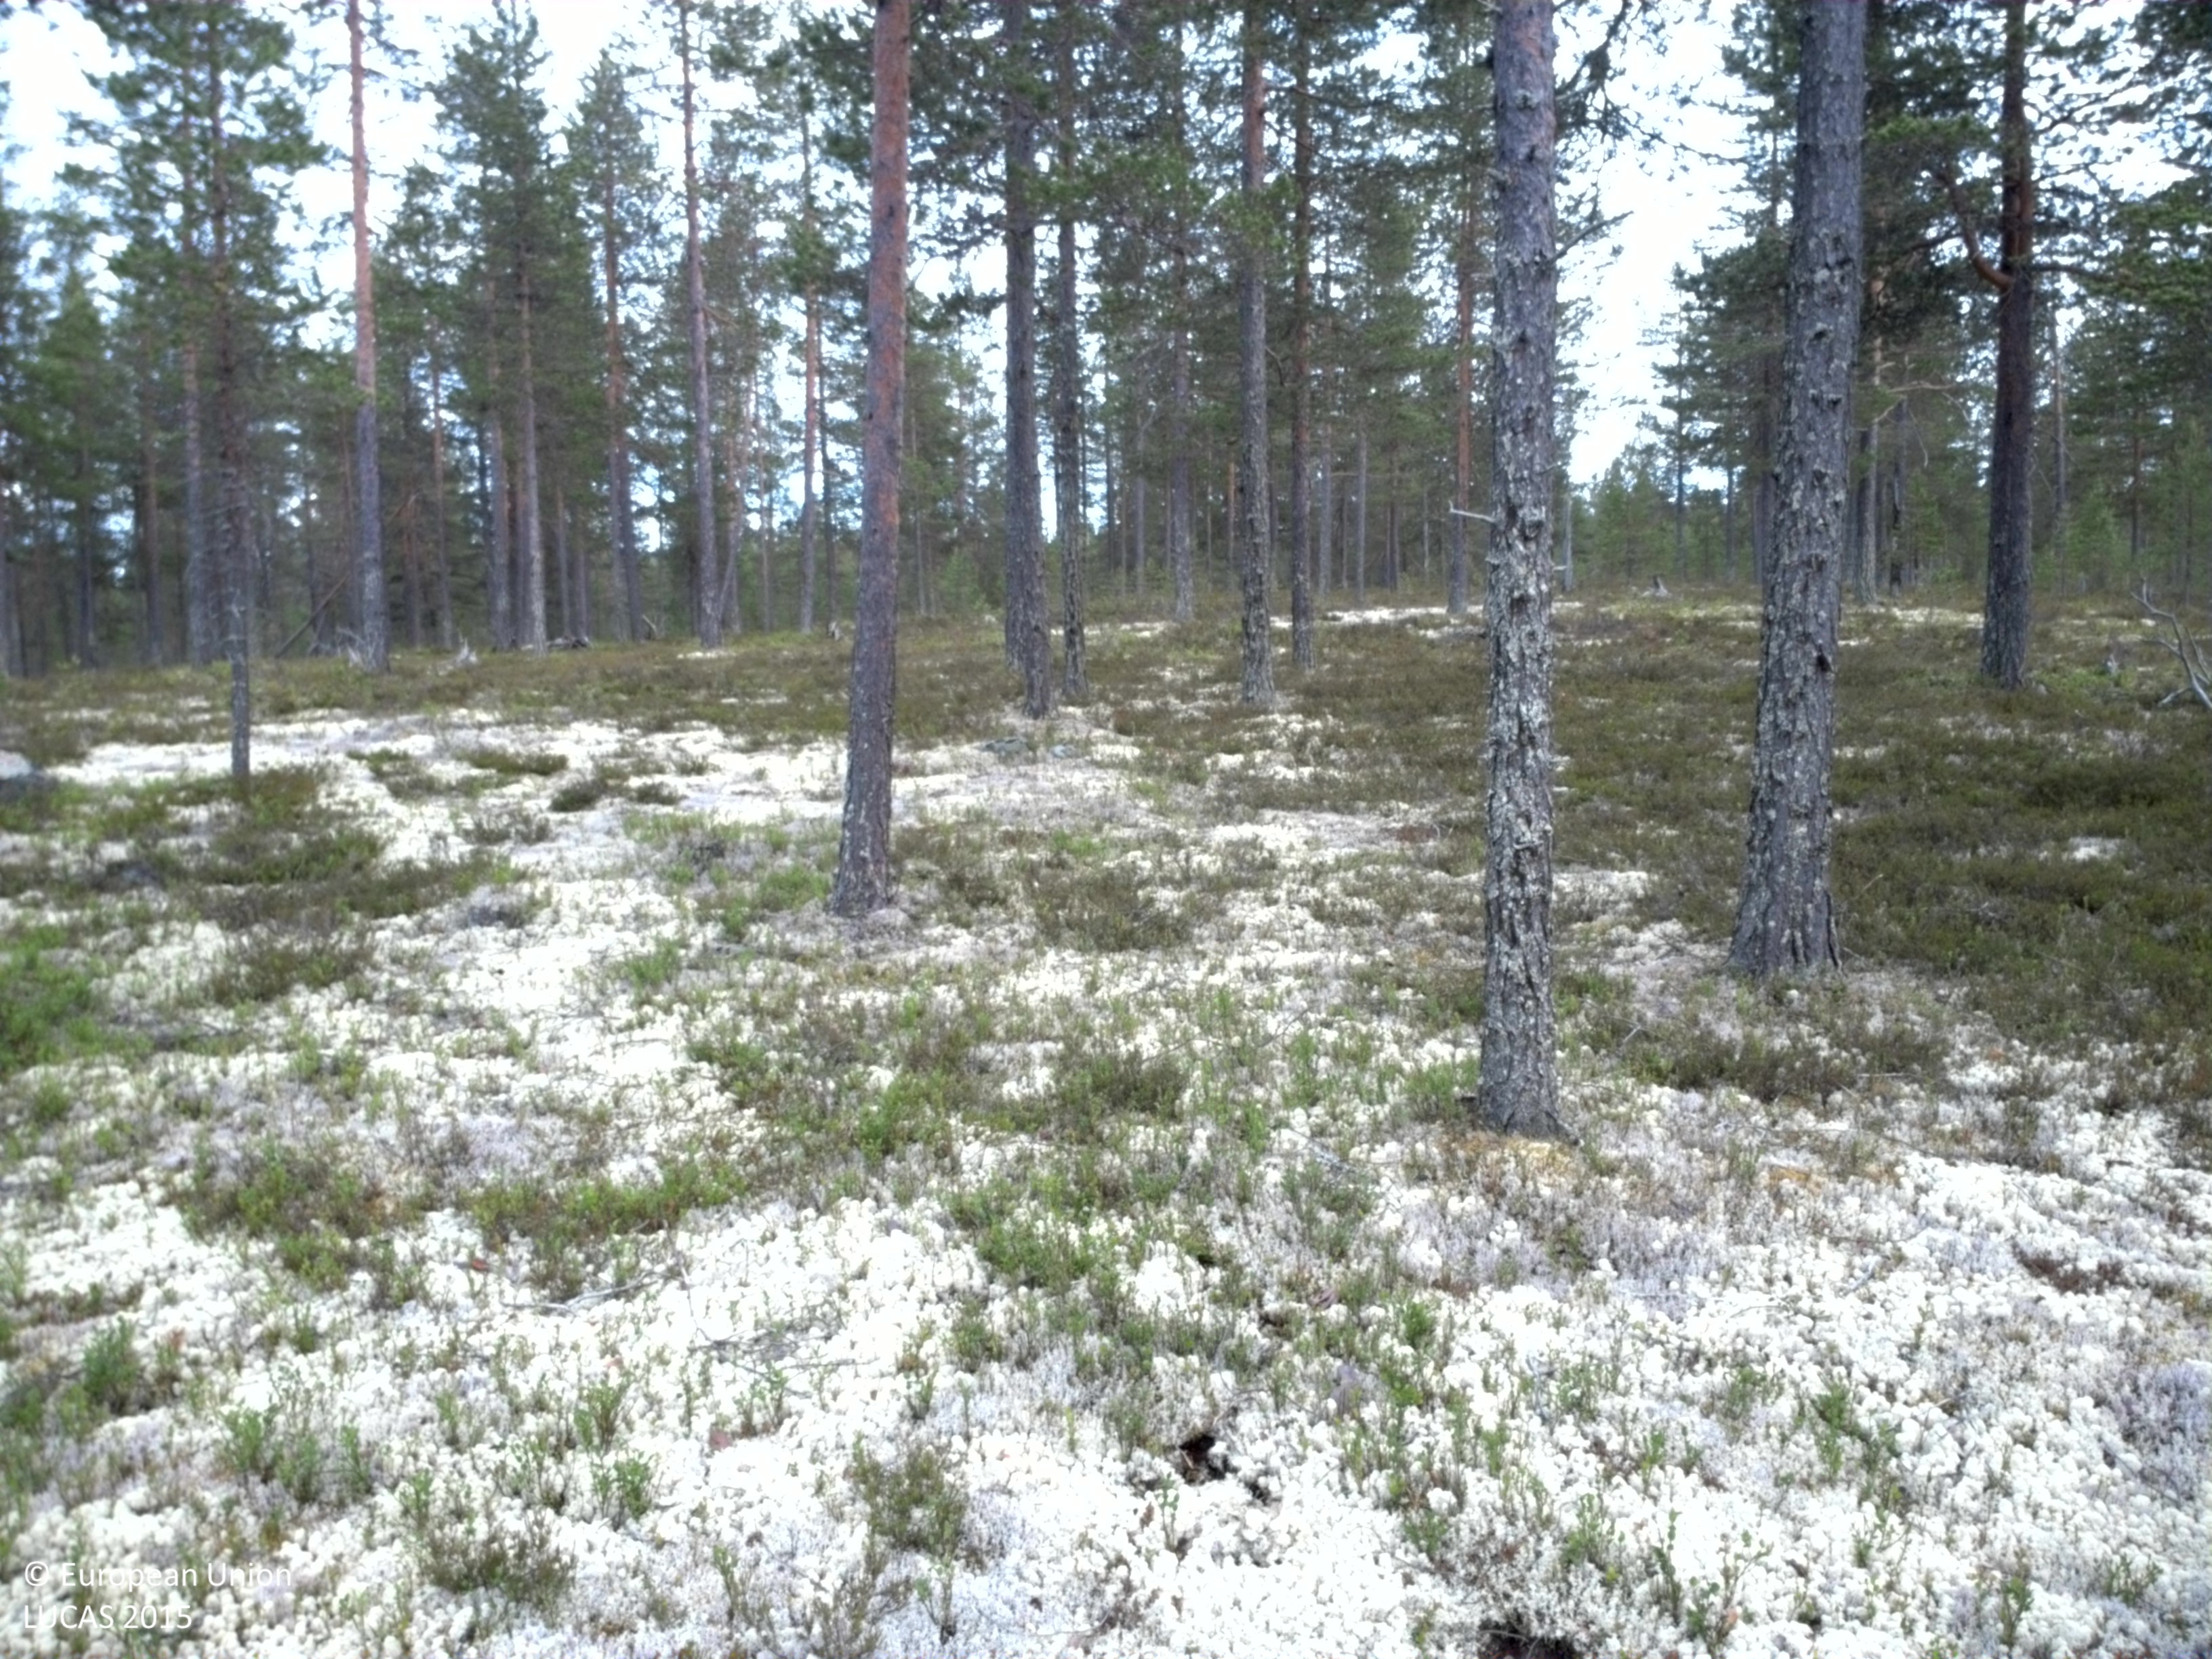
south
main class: Woodland
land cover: Pine dominated coniferous woodland
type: boreal forest
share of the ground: 25 - 50 %
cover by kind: coniferous forest trees 35 %, lichens and mosses 35 %, shrubs 30 %
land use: Community services
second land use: Forestry
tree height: < 5 m
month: July
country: SE
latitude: 61.5414
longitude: 13.5800
